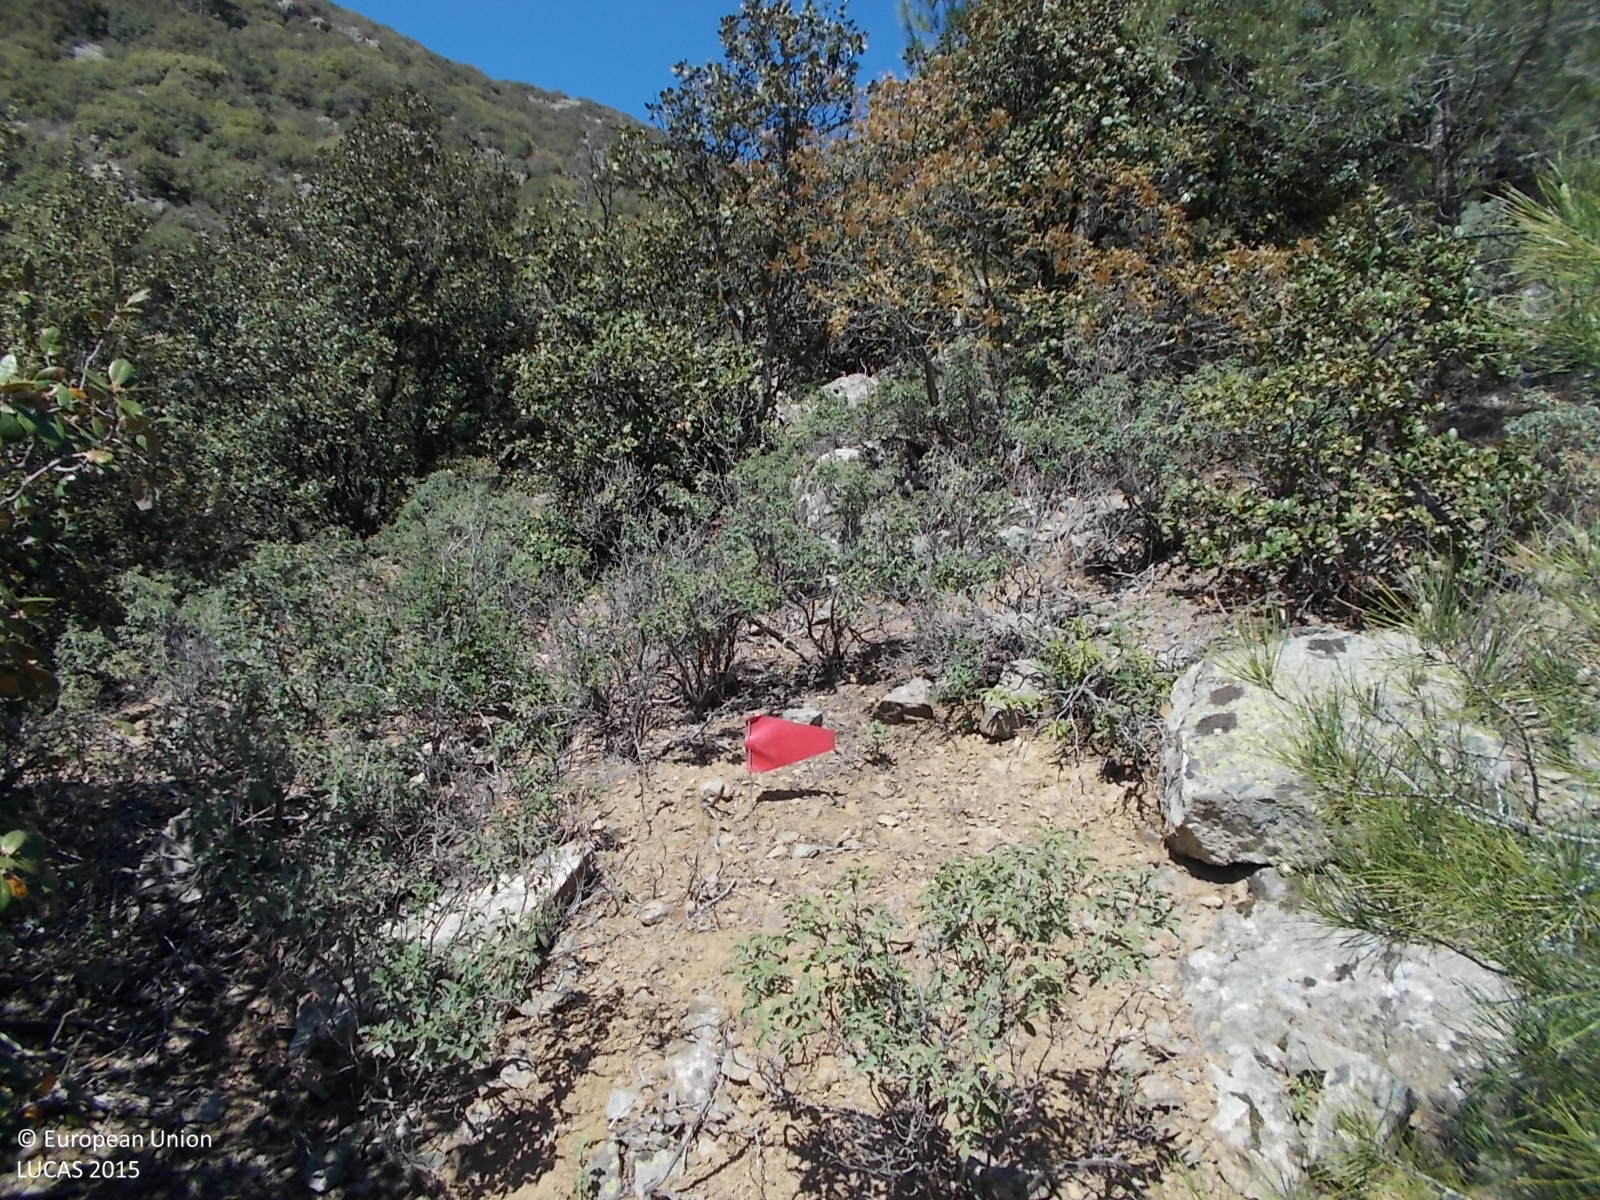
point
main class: Shrubland
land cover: Shrubland with sparse tree cover
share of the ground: > 75 %
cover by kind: shrubs 95 %, broadleaved forest trees 5 %
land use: Semi-natural and natural areas not in use
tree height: > 5 m
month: May
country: CY
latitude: 34.8929
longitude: 33.0532
